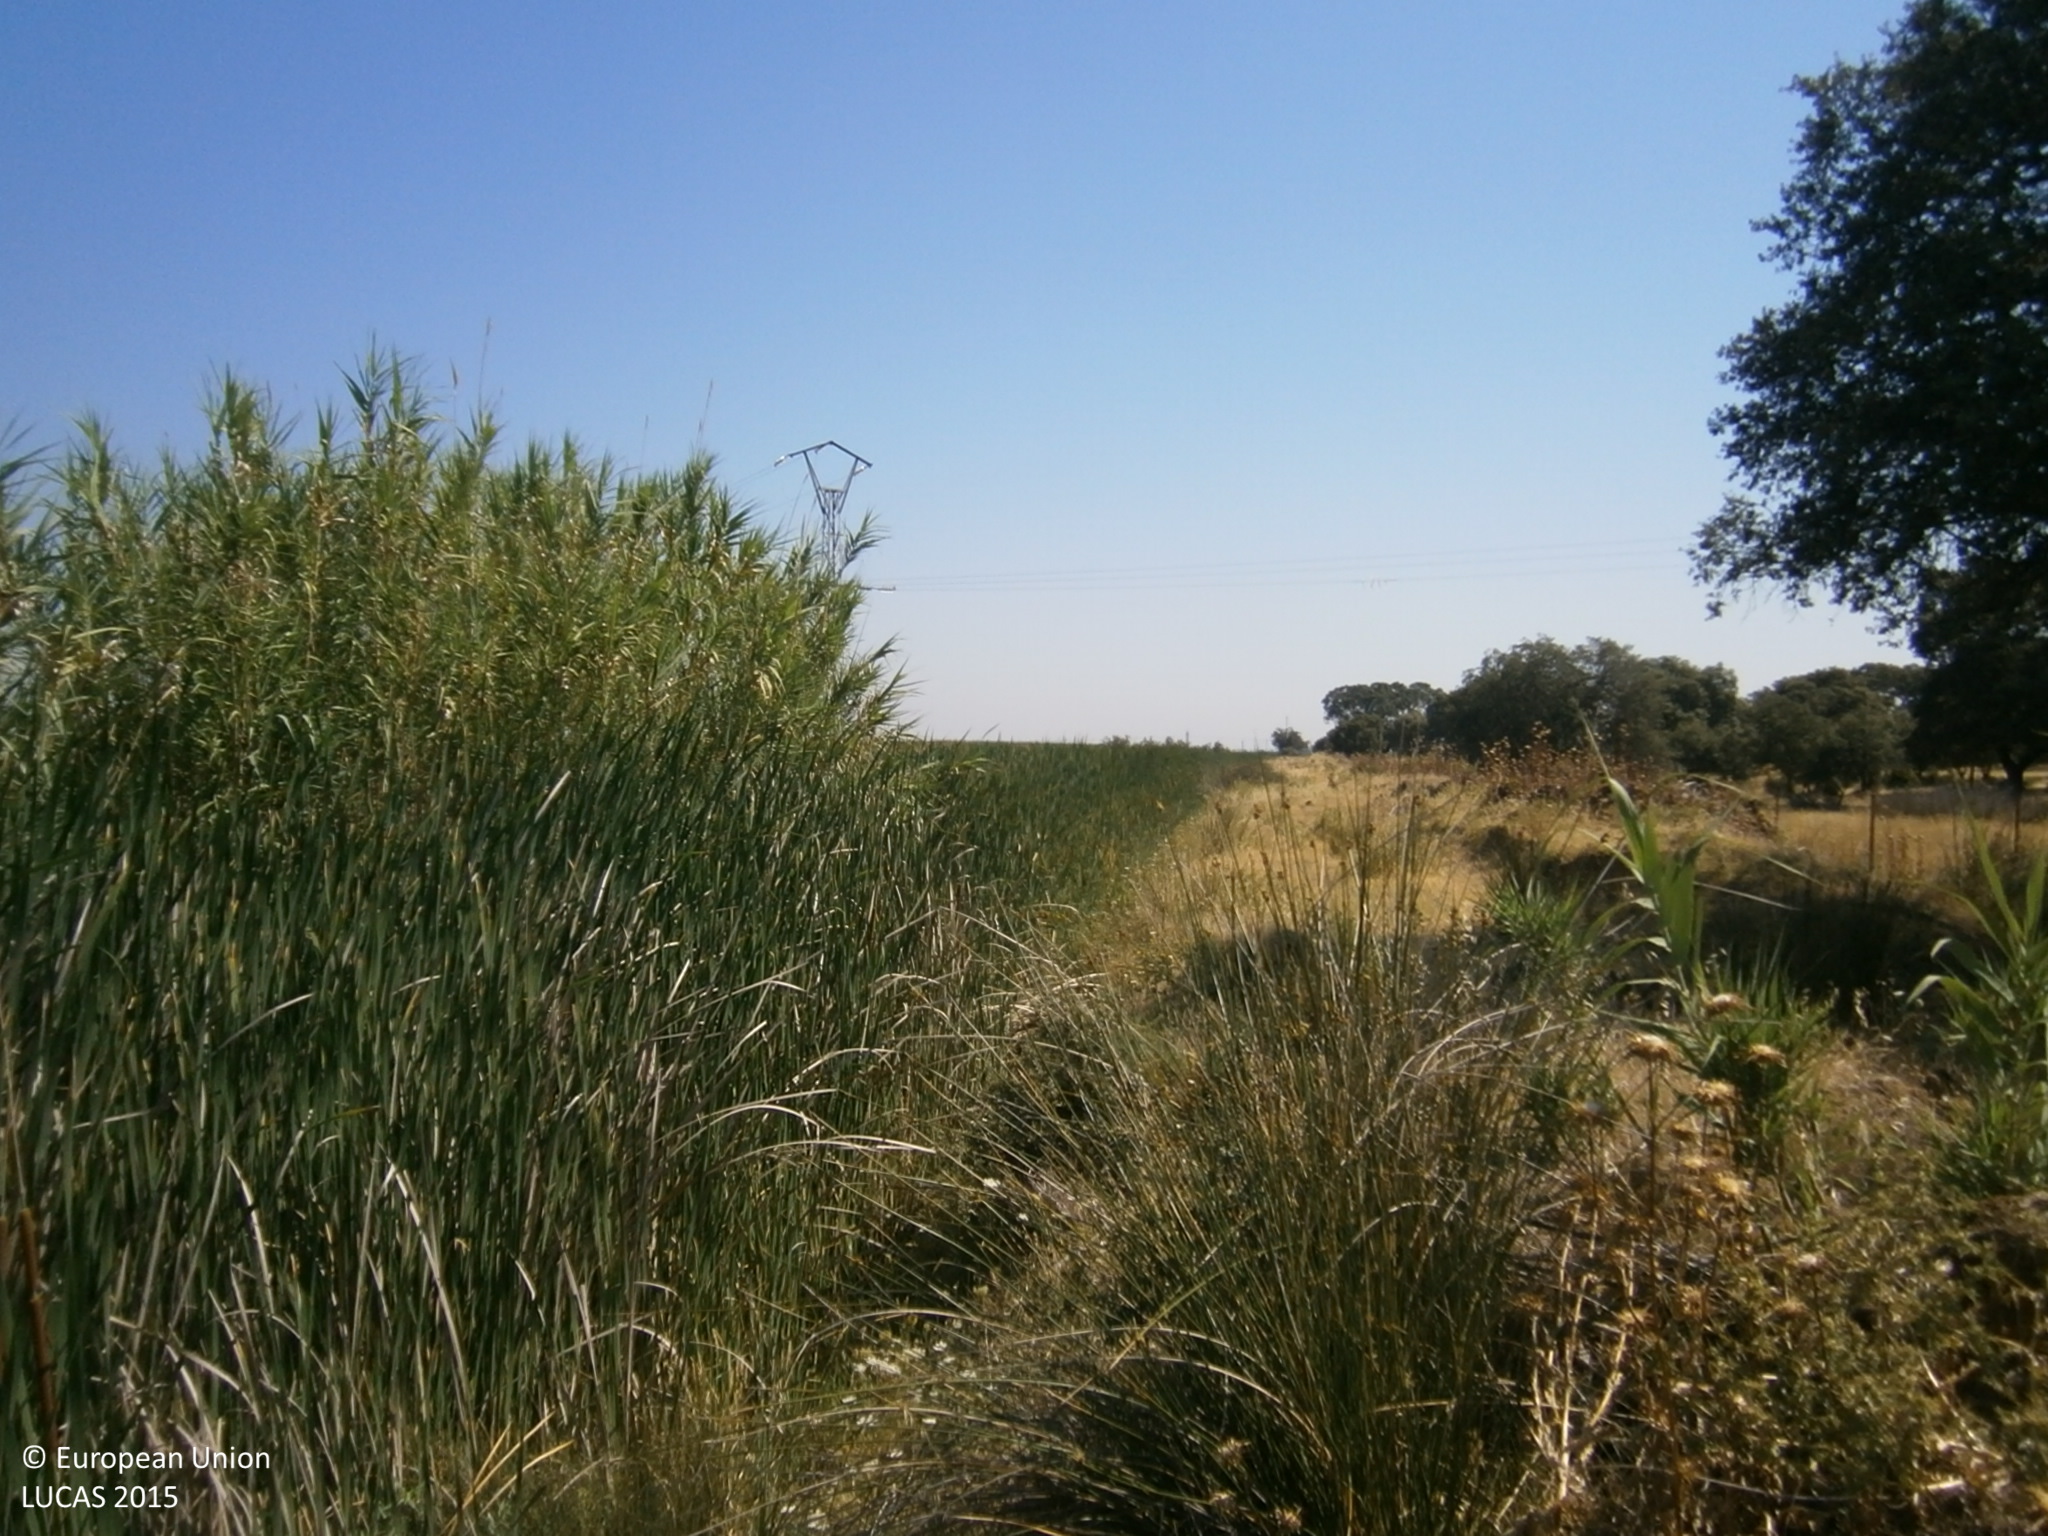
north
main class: Cropland
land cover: Tomatoes
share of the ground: > 75 %
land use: Agriculture (excluding fallow land and kitchen gardens)
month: June
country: ES
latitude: 38.8507
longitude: -6.7610
